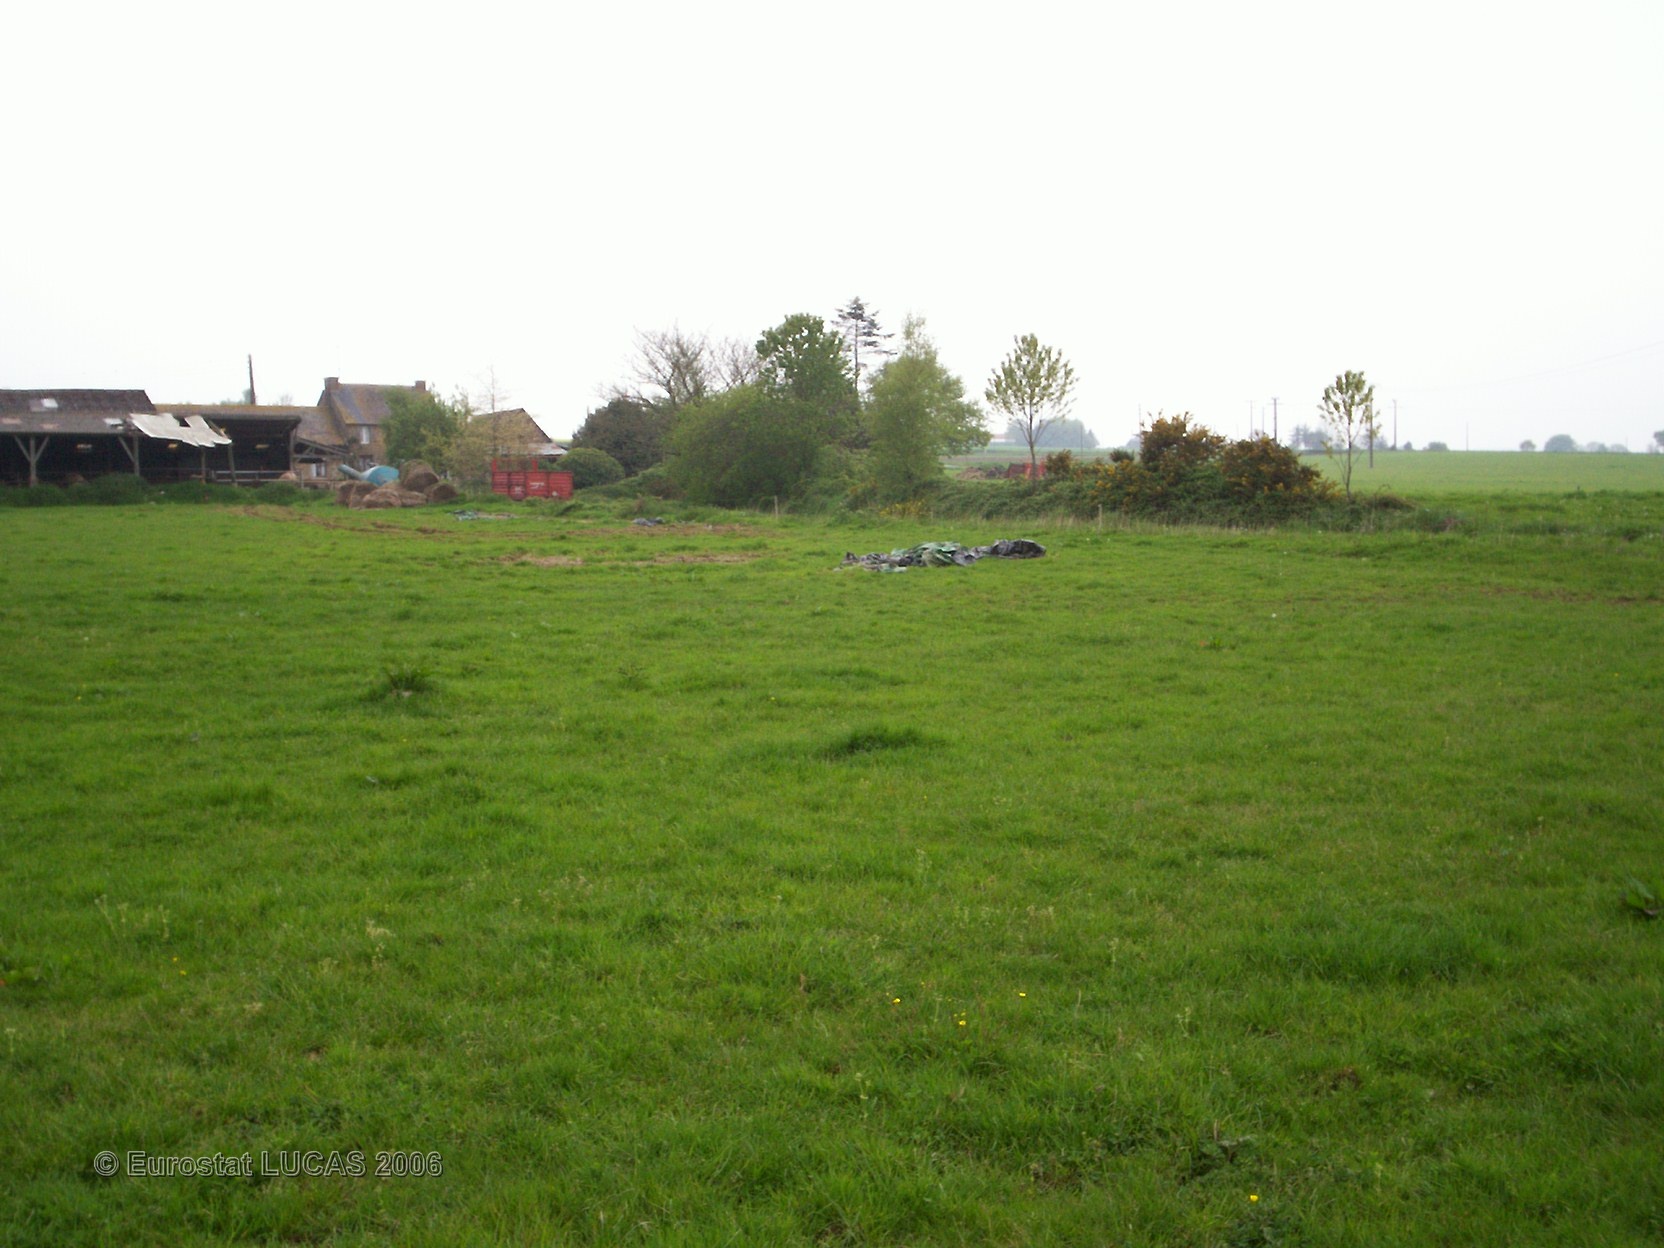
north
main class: Grassland
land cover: Grassland without tree/shrub cover
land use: Agriculture (excluding fallow land and kitchen gardens)
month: May
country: FR
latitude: 48.2067
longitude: -2.9181
